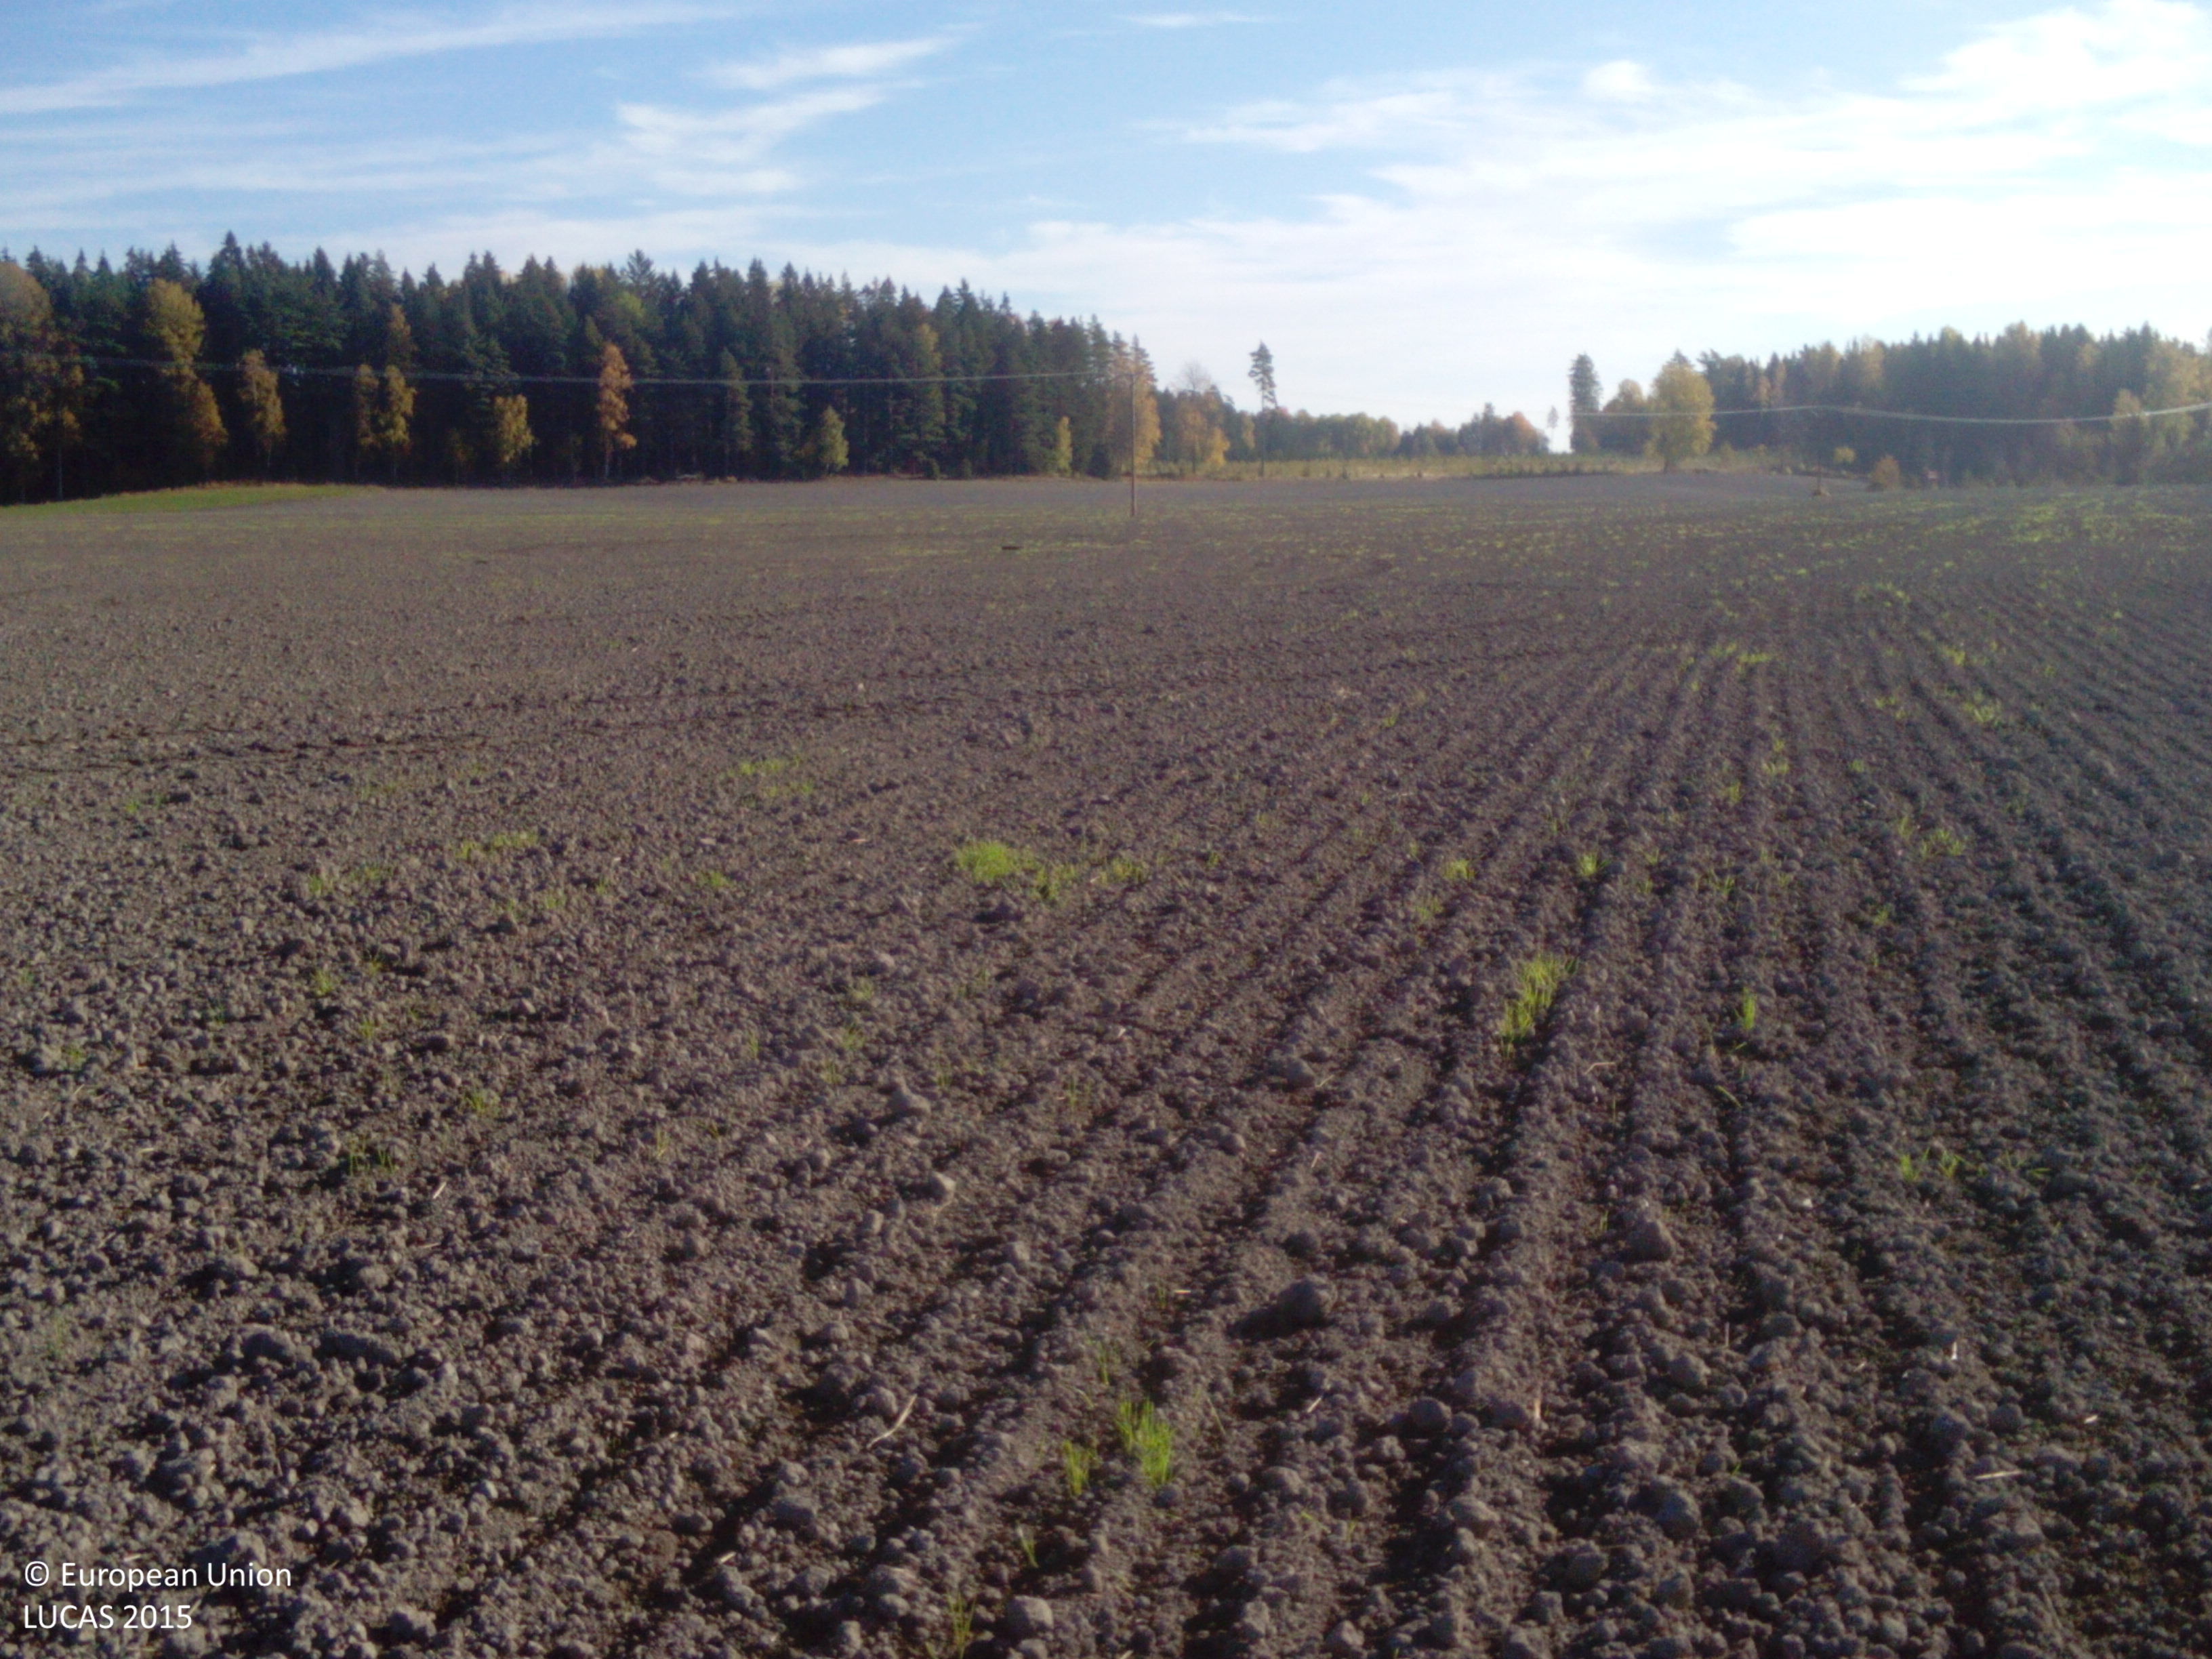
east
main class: Cropland
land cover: Common wheat
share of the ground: < 10 %
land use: Agriculture (excluding fallow land and kitchen gardens)
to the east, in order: Common wheat; Electric lines; Common wheat
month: October
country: SE
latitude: 58.9106
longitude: 16.5056
